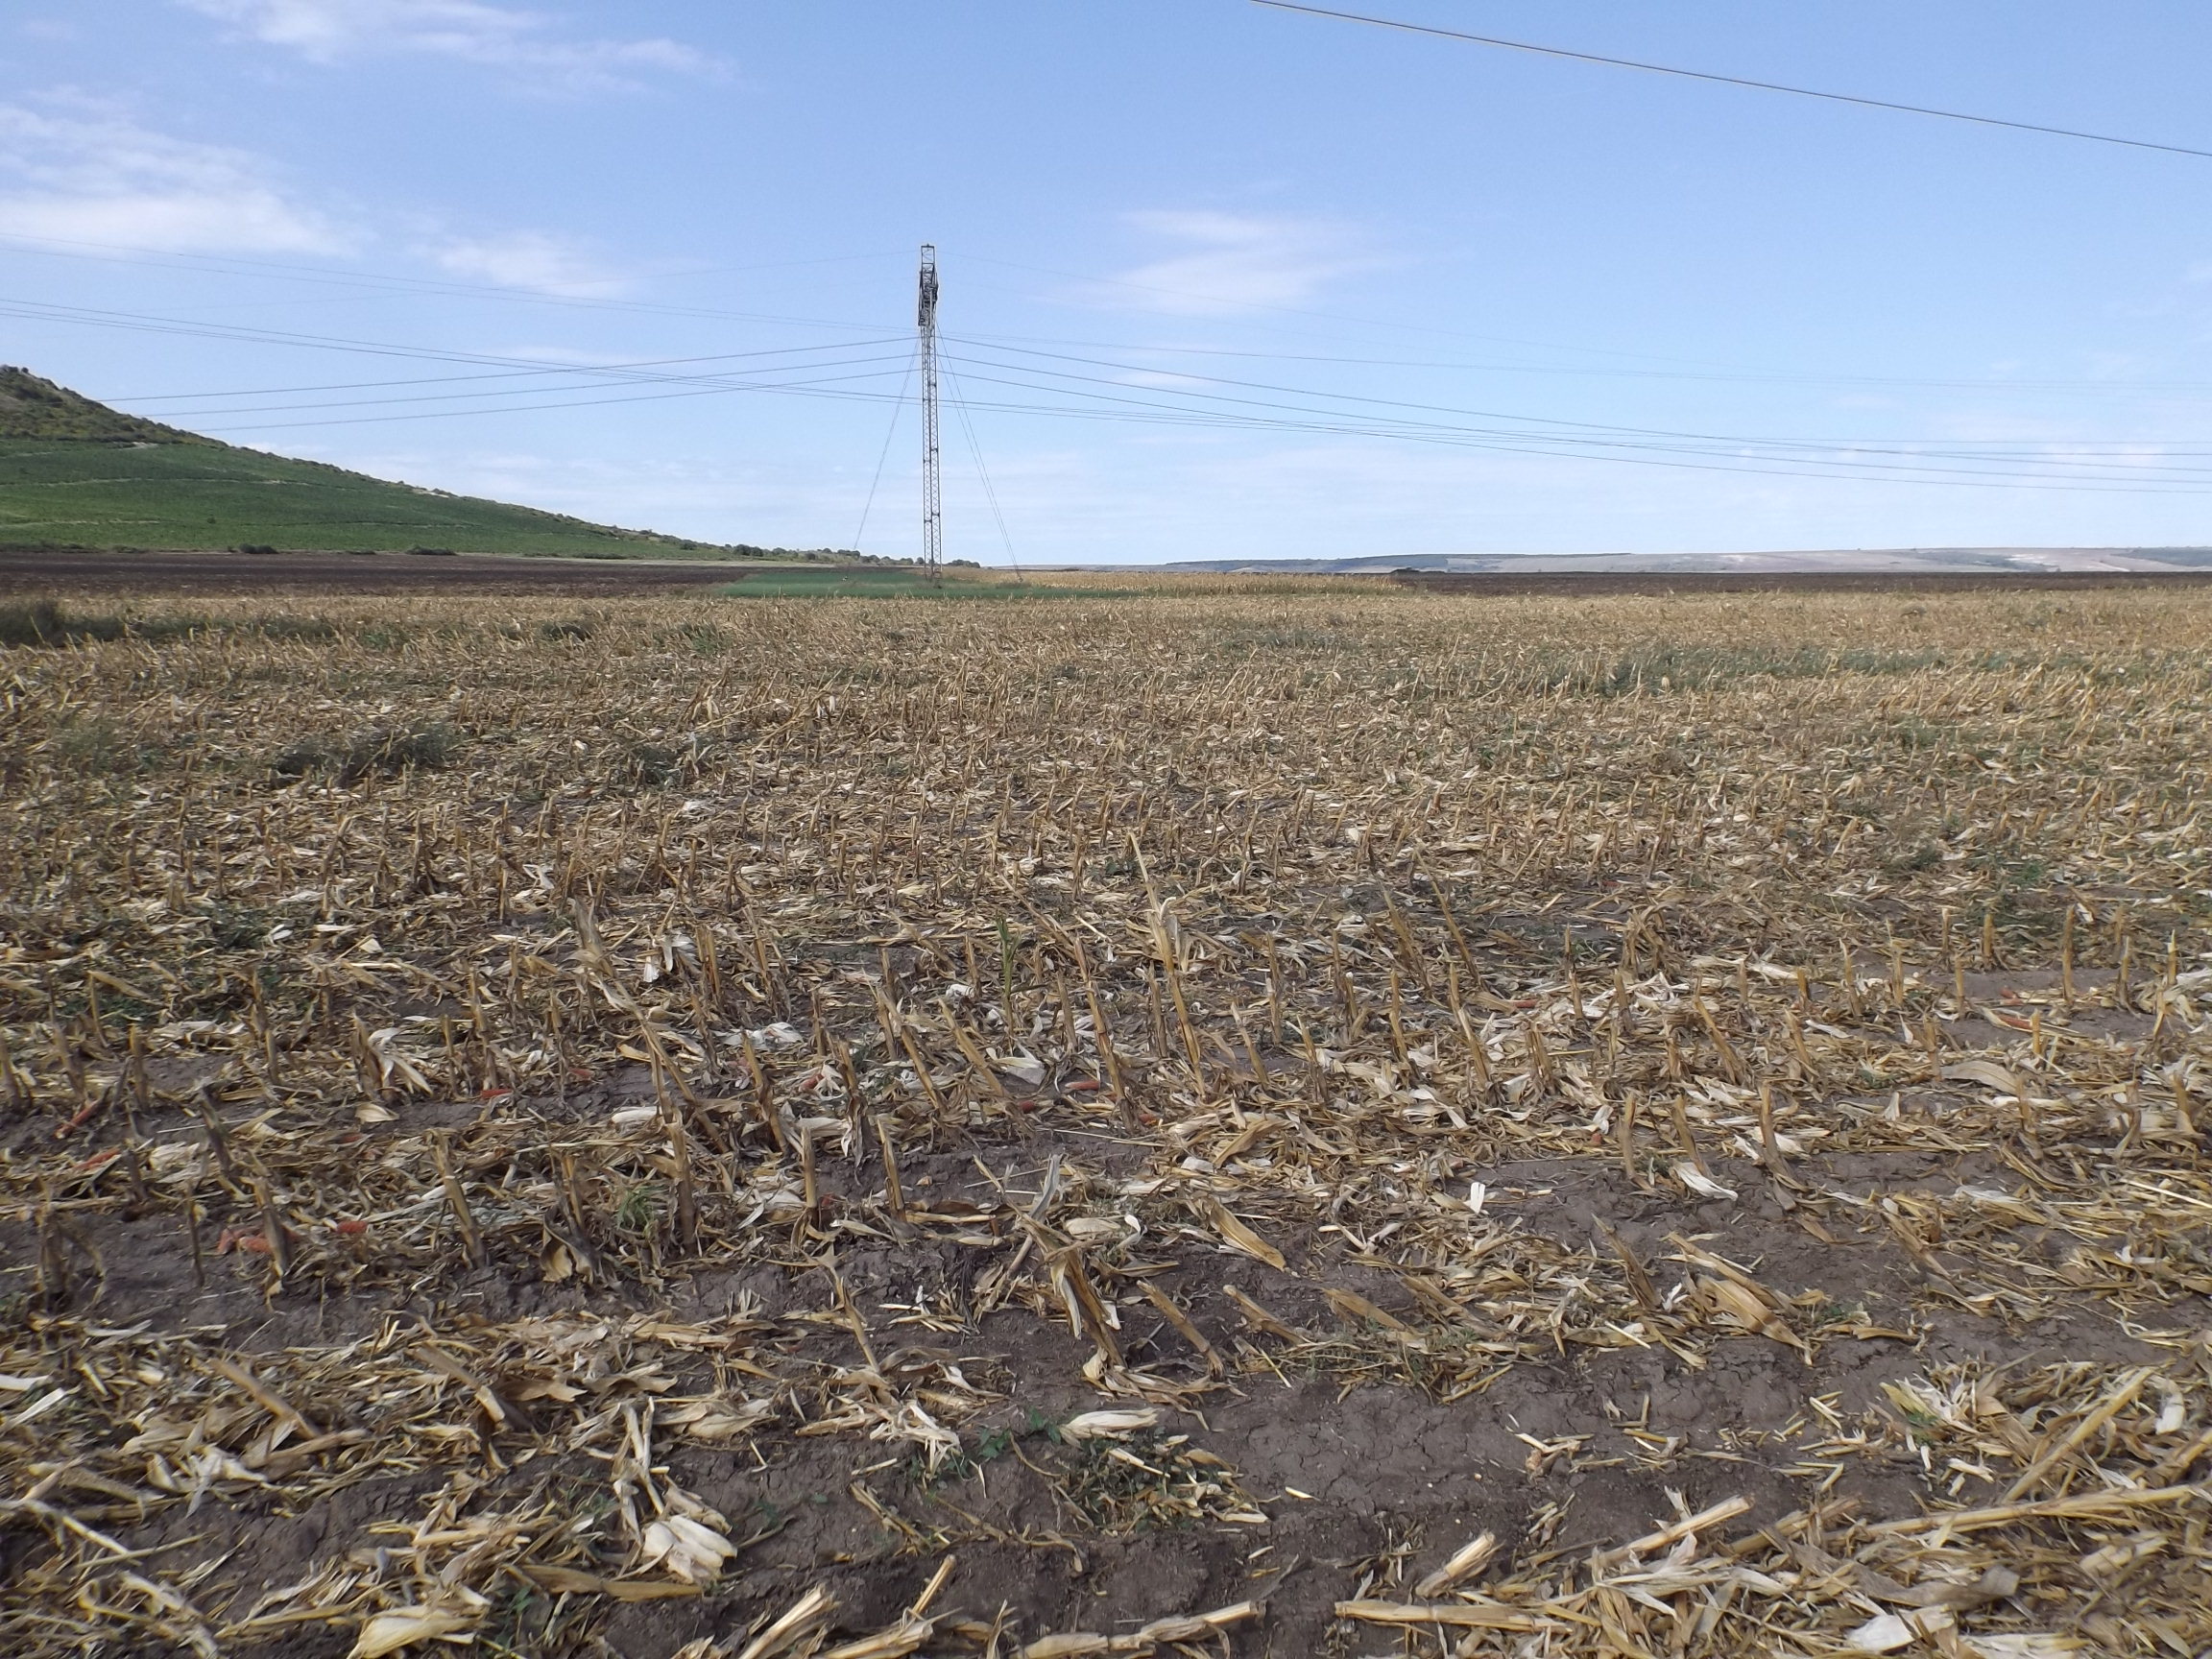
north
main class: Cropland
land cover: Maize
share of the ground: < 10 %
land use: Agriculture (excluding fallow land and kitchen gardens)
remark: Harvested field
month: September
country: BG
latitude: 43.3214
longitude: 27.3260
